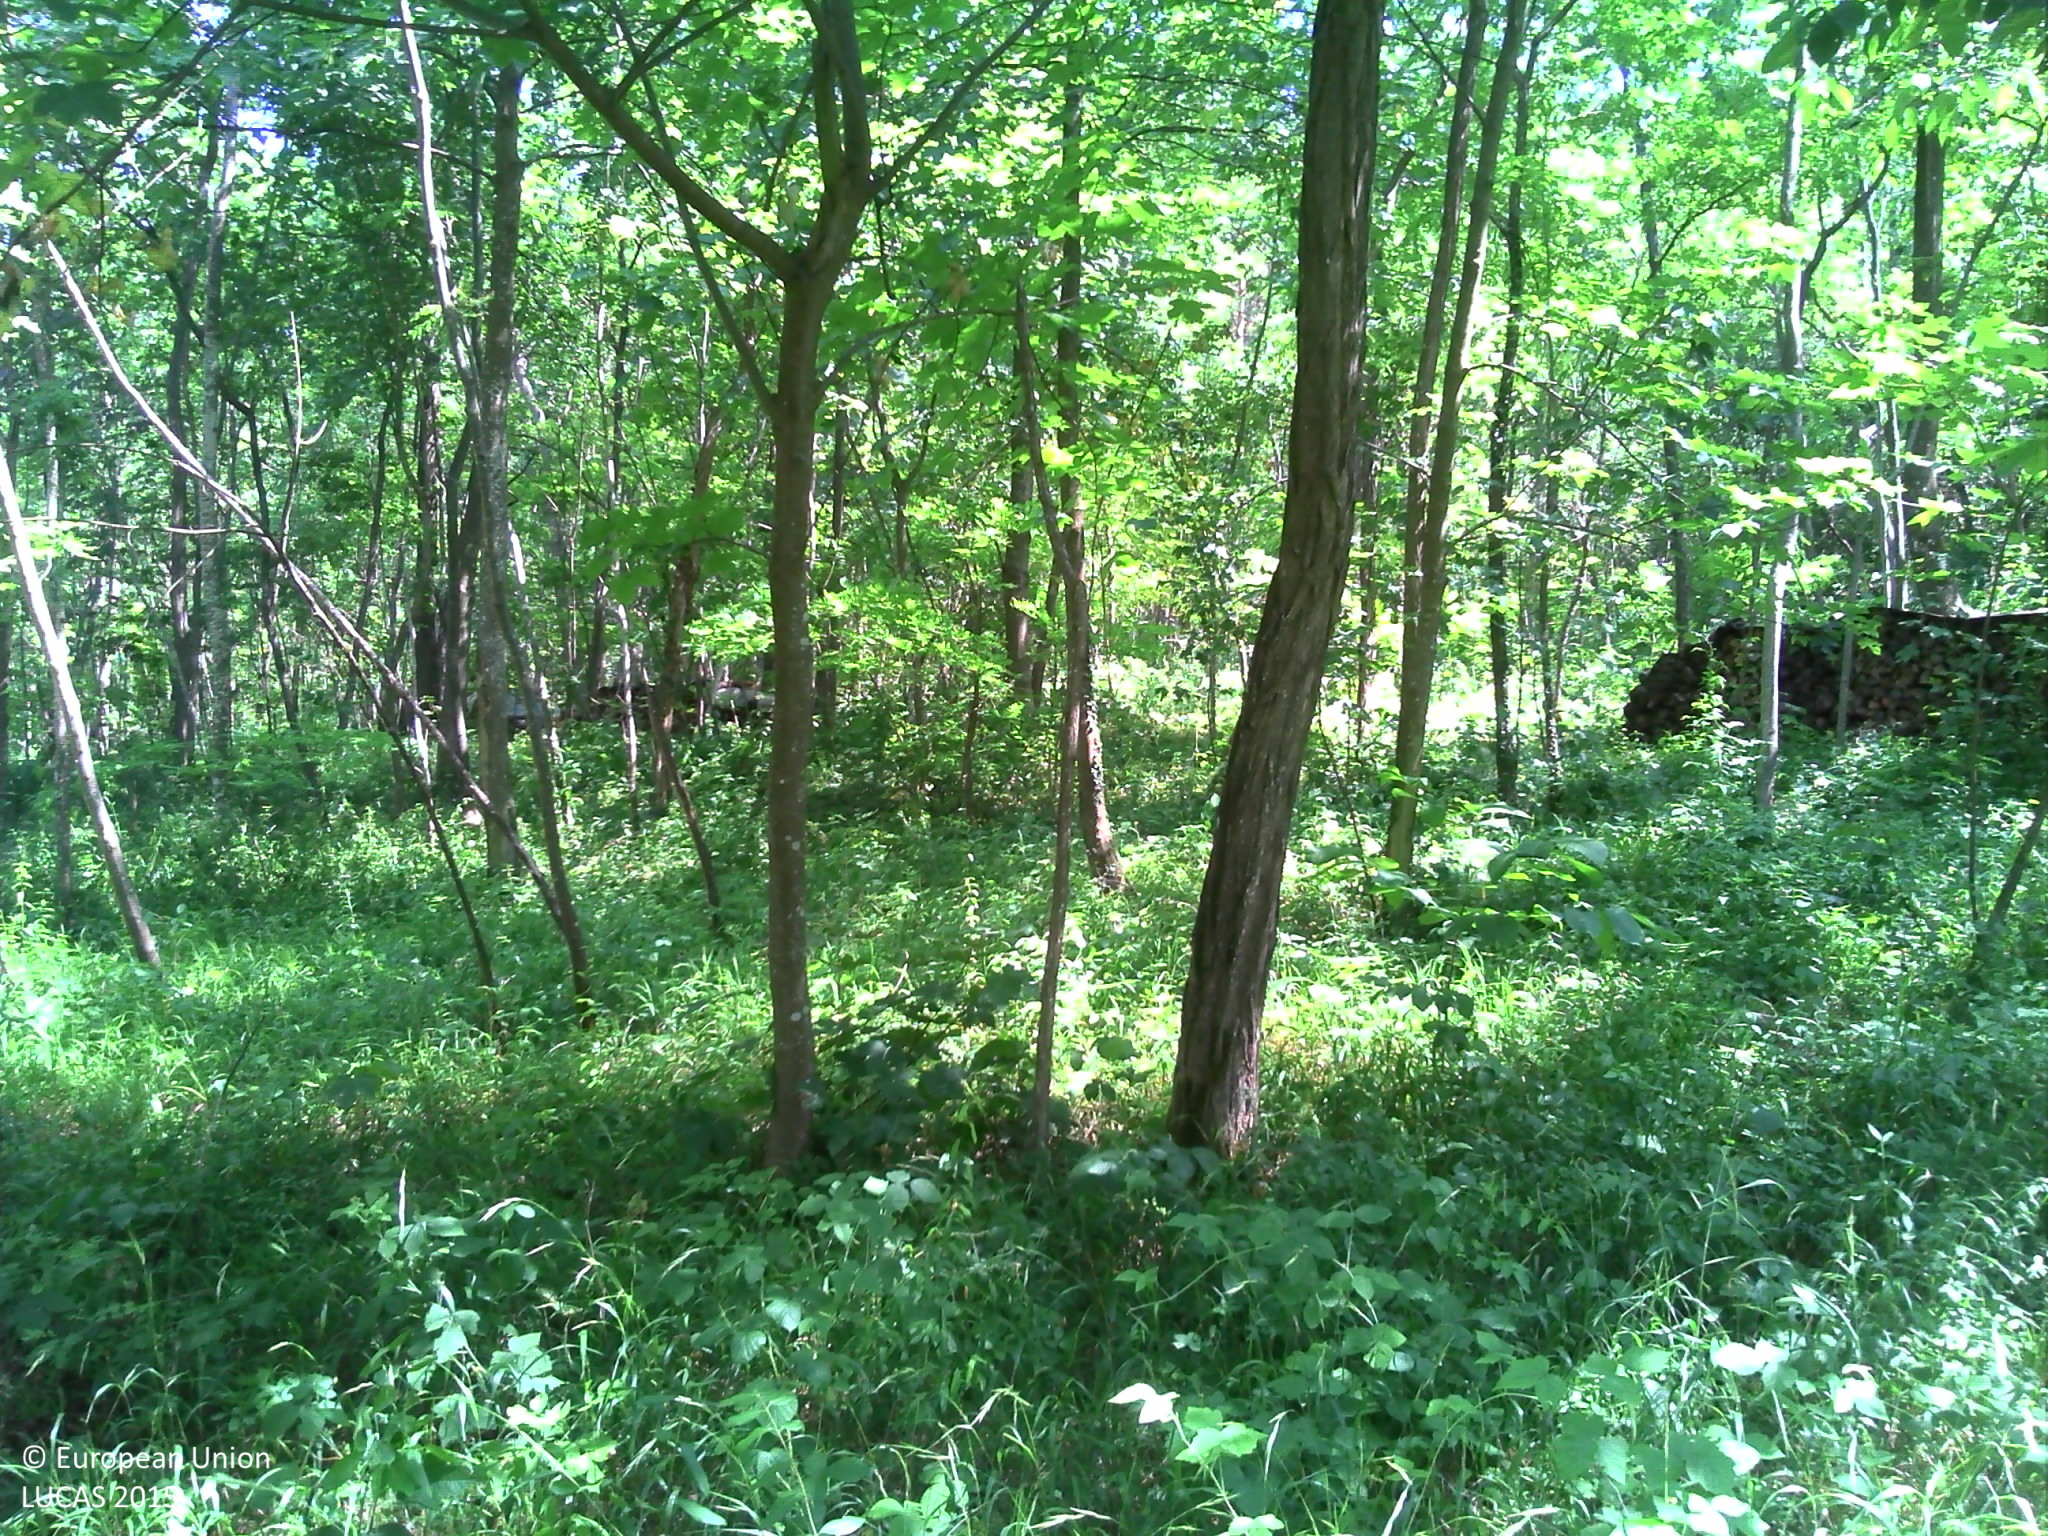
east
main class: Woodland
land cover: Broadleaved woodland
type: mesophytic deciduous forest
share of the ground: > 75 %
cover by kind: broadleaved forest trees 85 %, herbaceous plants 15 %
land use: Forestry
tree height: > 5 m
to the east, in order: Broadleaved woodland; Tracks; Broadleaved woodland; Tracks; Broadleaved woodland
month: July
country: FR
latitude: 48.5545
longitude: 7.4673
